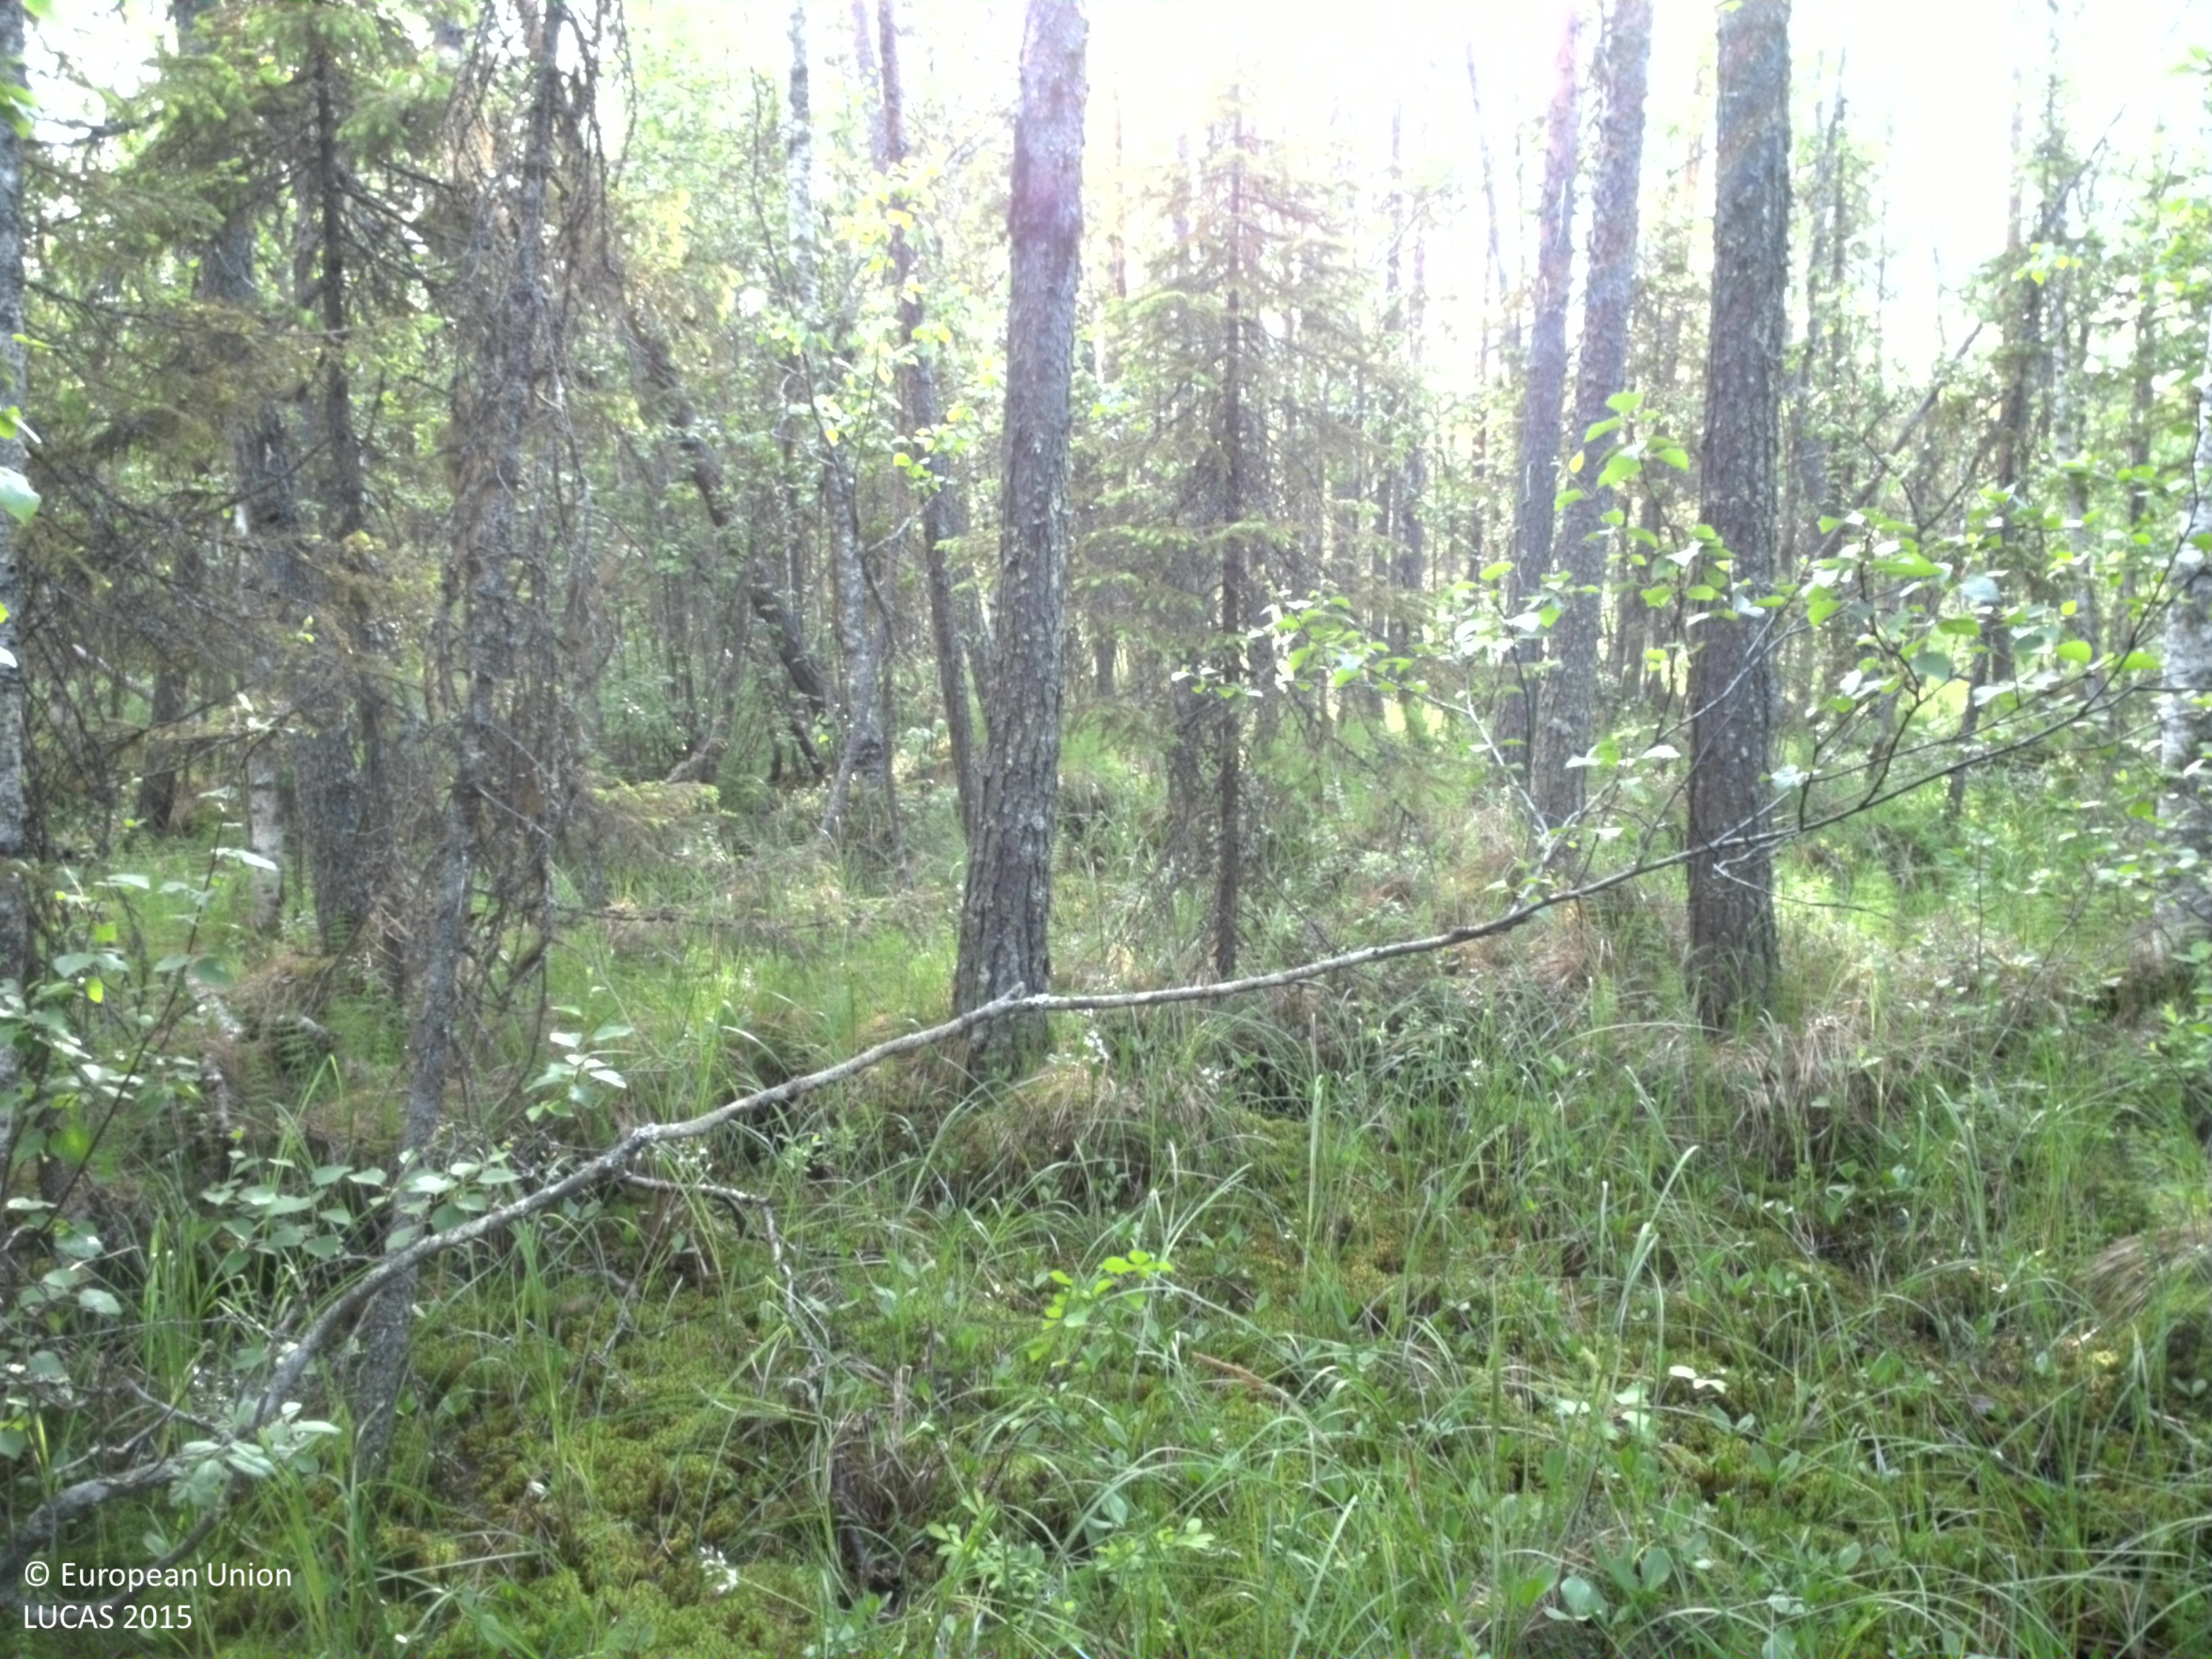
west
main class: Woodland
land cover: Pine dominated mixed woodland
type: mire and swamp forests
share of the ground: 50 - 75 %
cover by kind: broadleaved forest trees 30 %, coniferous forest trees 25 %, herbaceous plants 20 %, lichens and mosses 10 %, shrubs 5 %
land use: Semi-natural and natural areas not in use
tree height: > 5 m
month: June
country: SE
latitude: 66.2488
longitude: 22.7719
